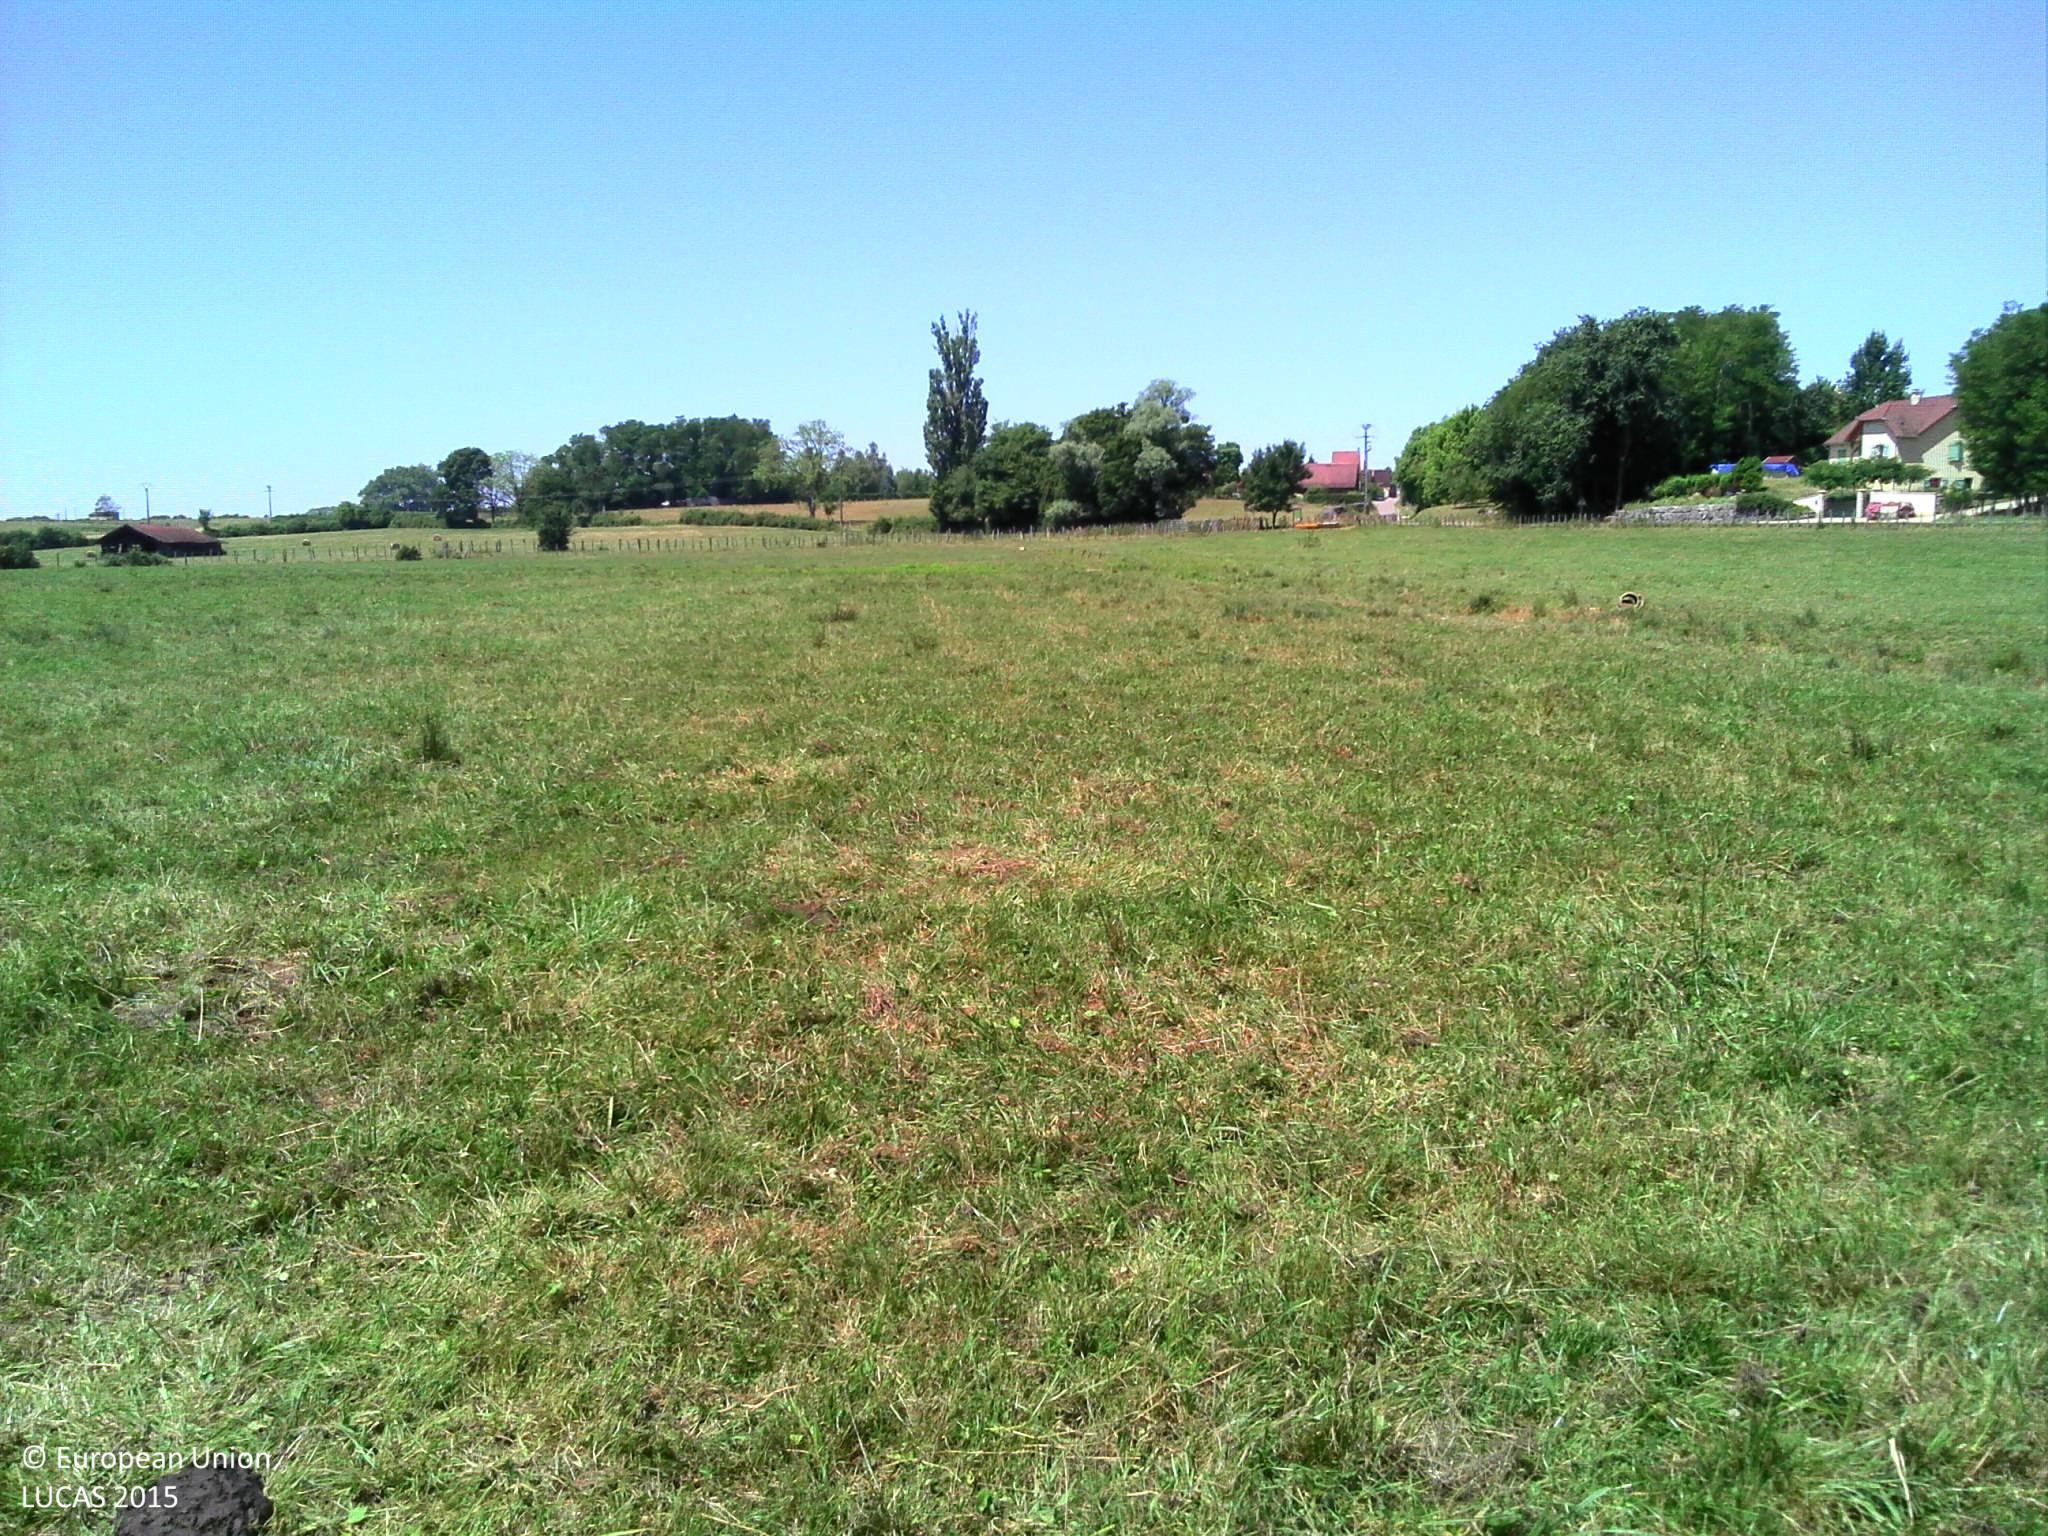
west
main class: Grassland
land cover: Grassland without tree/shrub cover
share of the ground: > 75 %
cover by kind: herbaceous plants 100 %
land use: Agriculture (excluding fallow land and kitchen gardens)
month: June
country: FR
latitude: 46.6711
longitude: 5.4927
